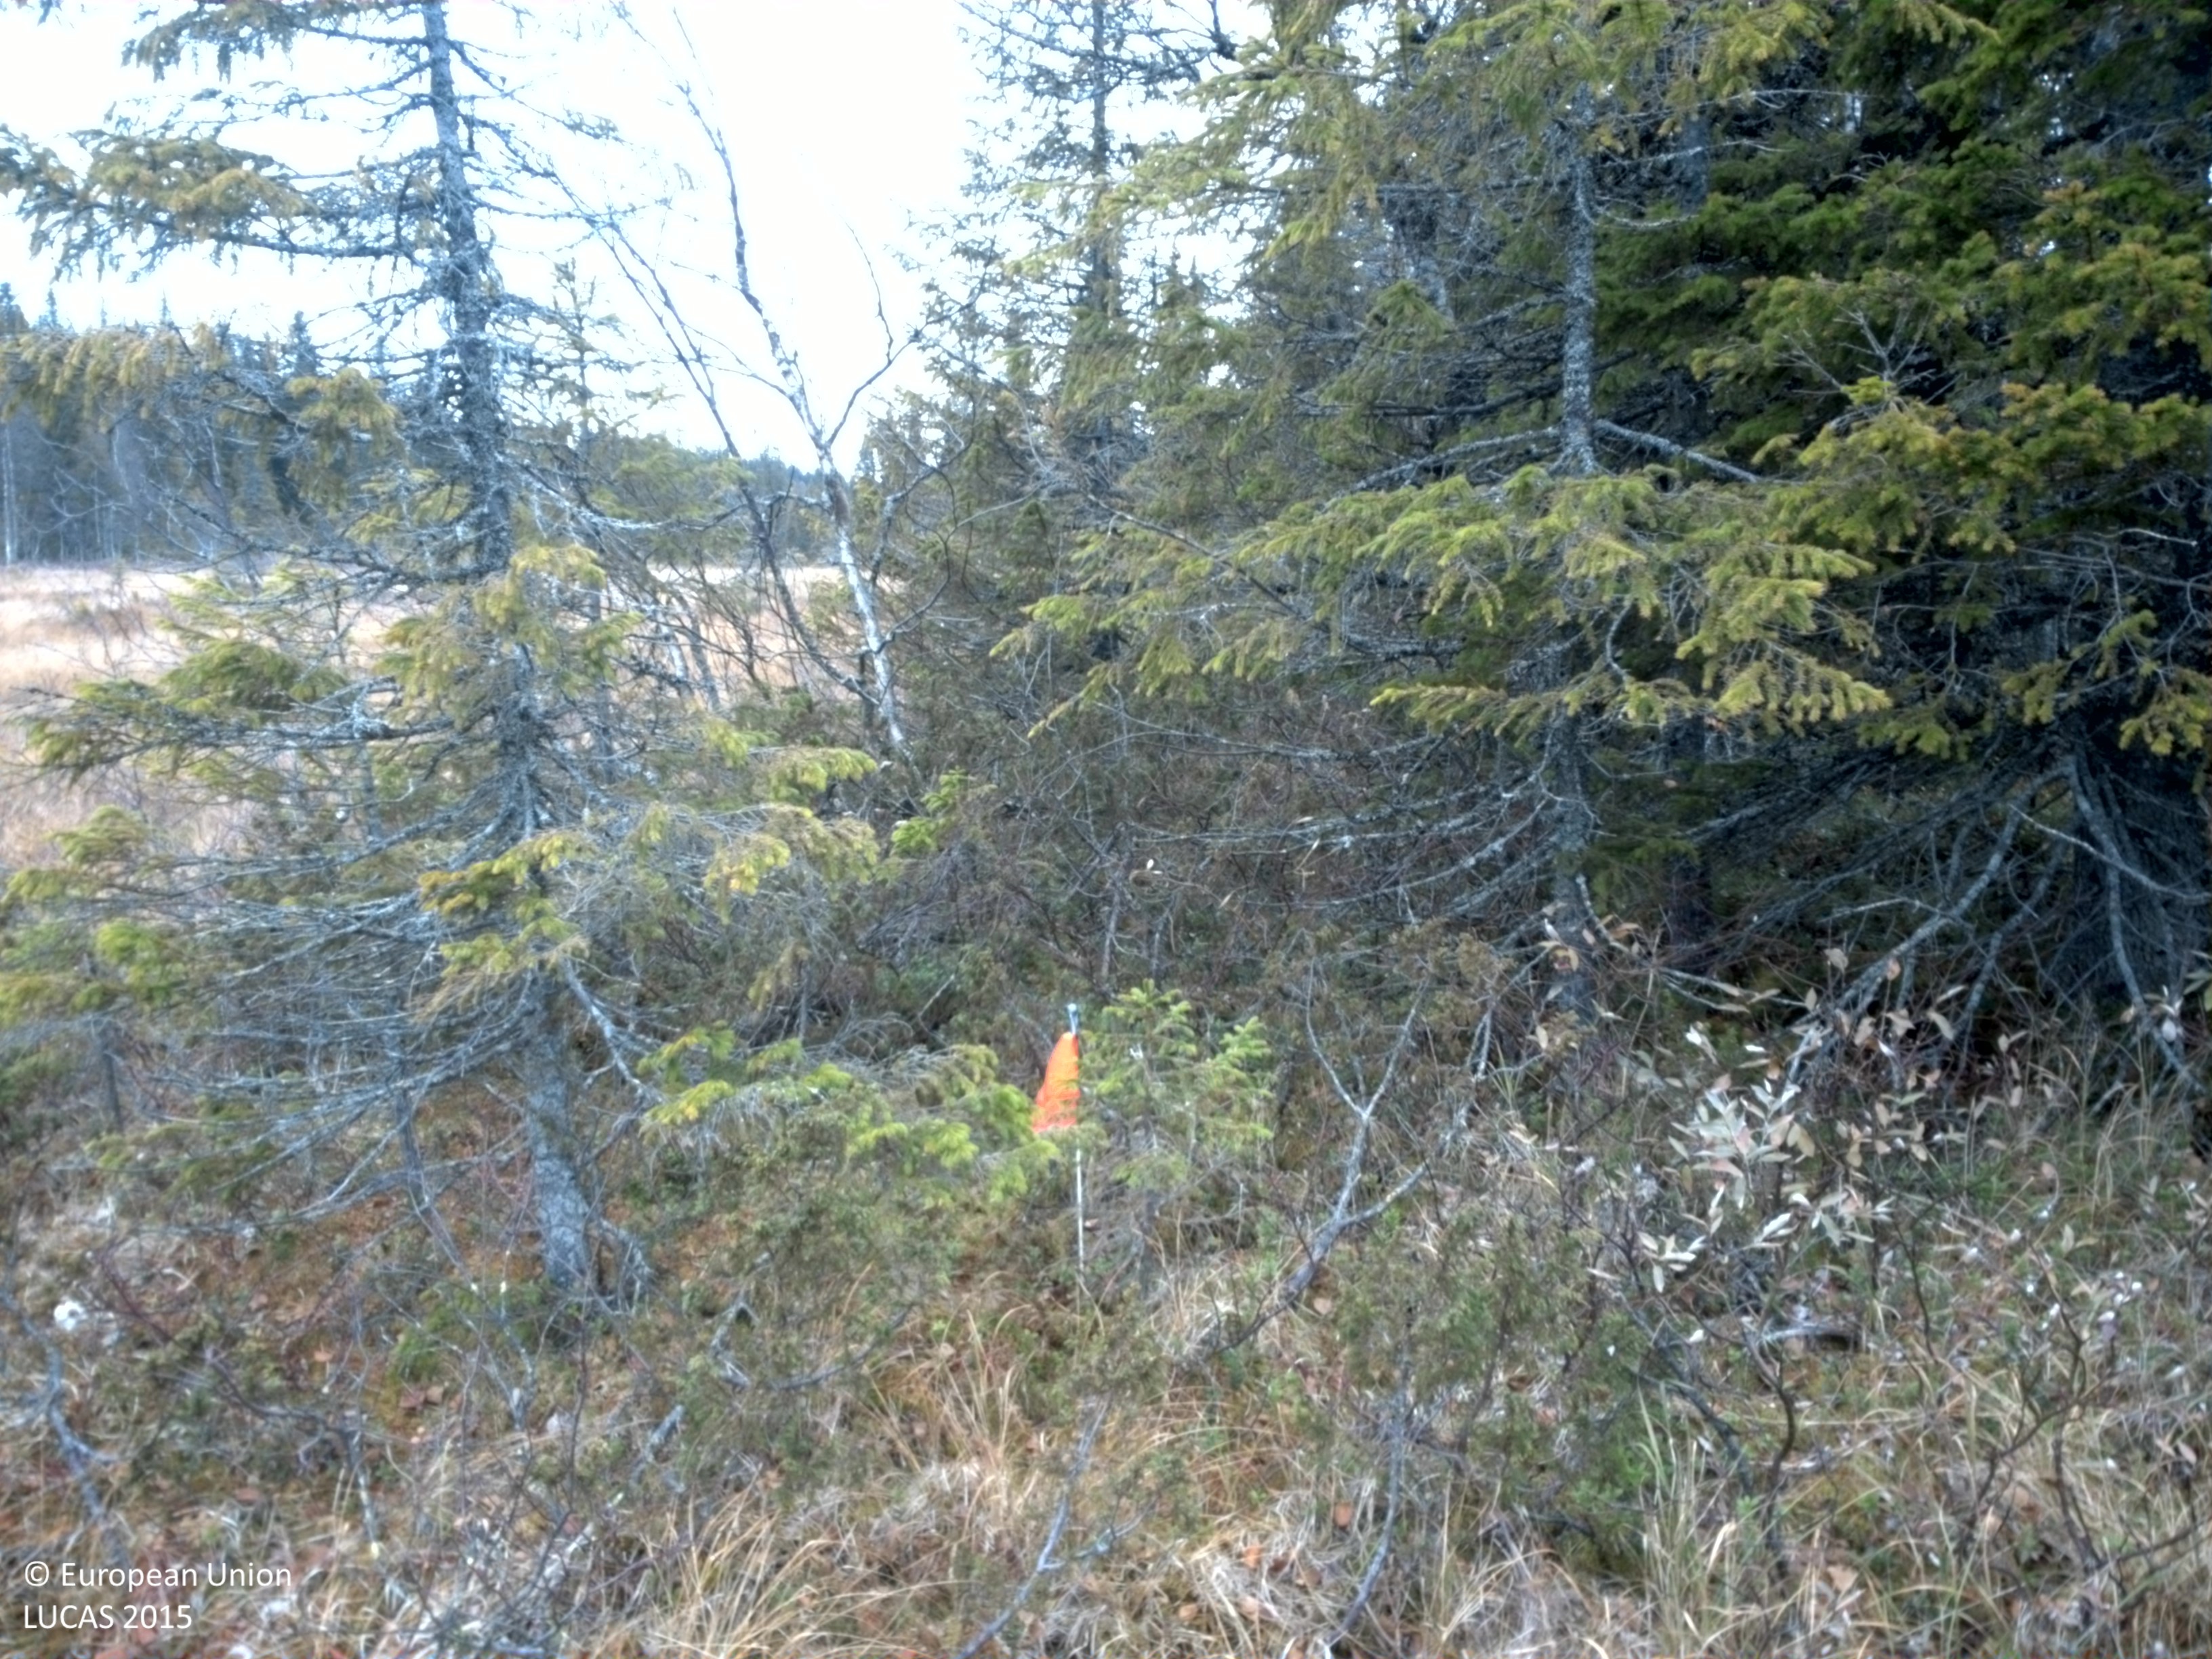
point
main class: Woodland
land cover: Spruce dominated mixed woodland
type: boreal forest
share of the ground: 25 - 50 %
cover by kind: shrubs 40 %, coniferous forest trees 20 %, broadleaved forest trees 20 %, herbaceous plants 10 %, lichens and mosses 10 %
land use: Forestry
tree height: > 5 m
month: October
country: SE
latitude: 64.8842
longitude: 16.8696
